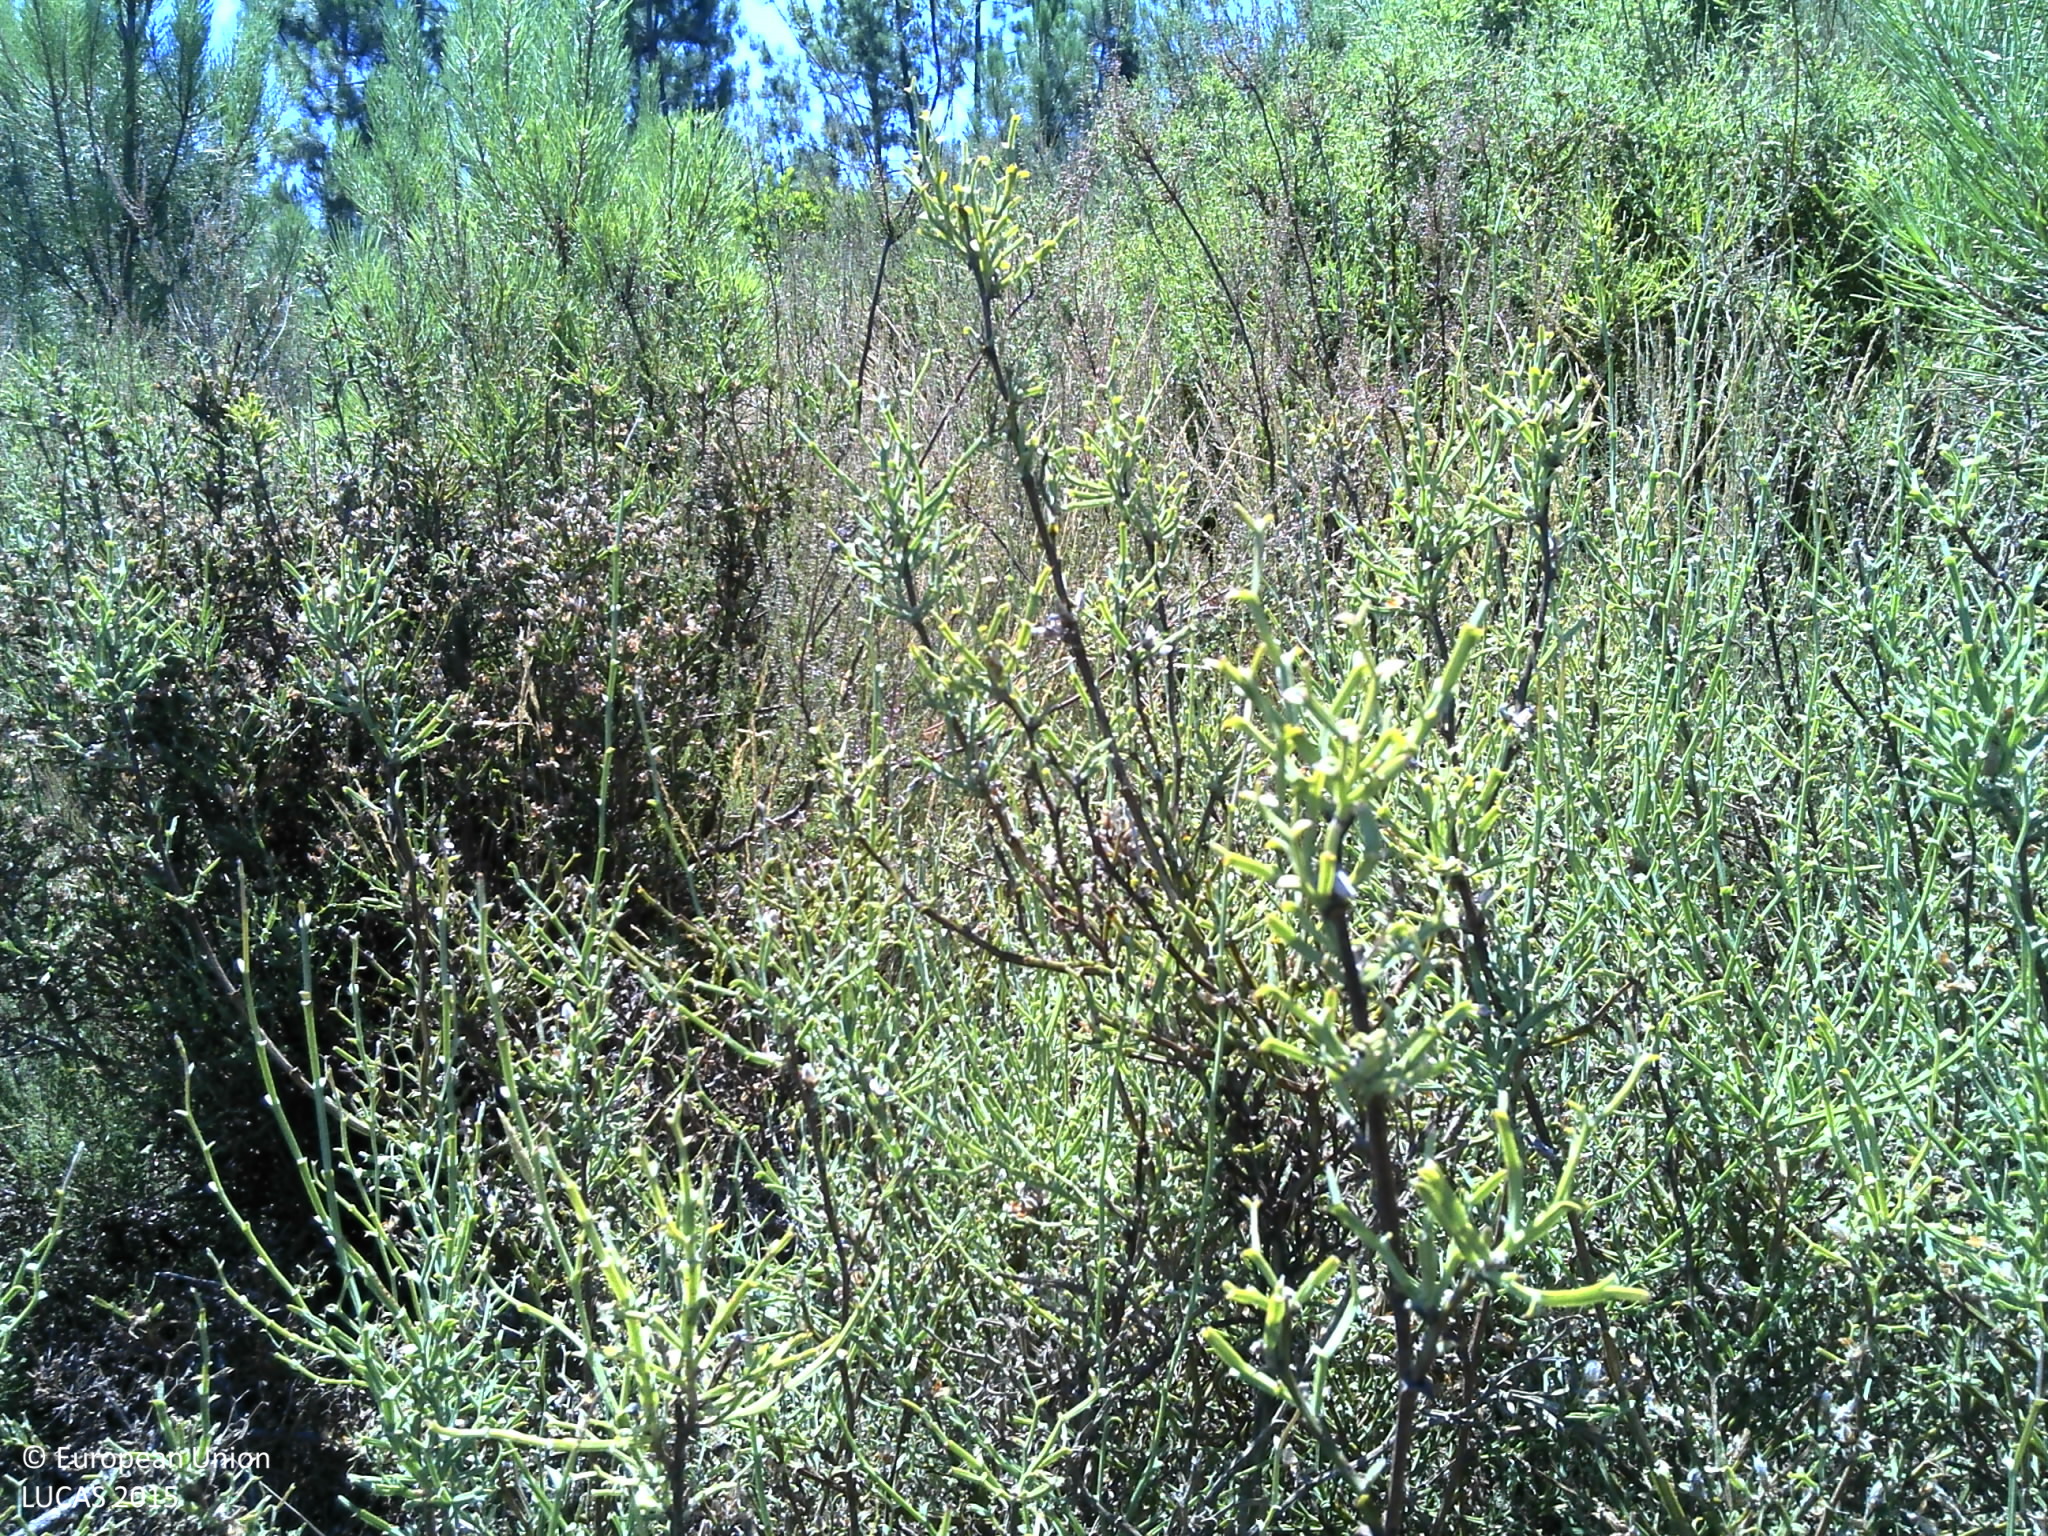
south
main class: Shrubland
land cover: Shrubland with sparse tree cover
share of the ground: > 75 %
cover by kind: shrubs 75 %, unconsolidated bare surface 15 %, coniferous forest trees 5 %, herbaceous plants 5 %
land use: Forestry
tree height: > 5 m
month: July
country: PT
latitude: 39.8039
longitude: -8.1132
